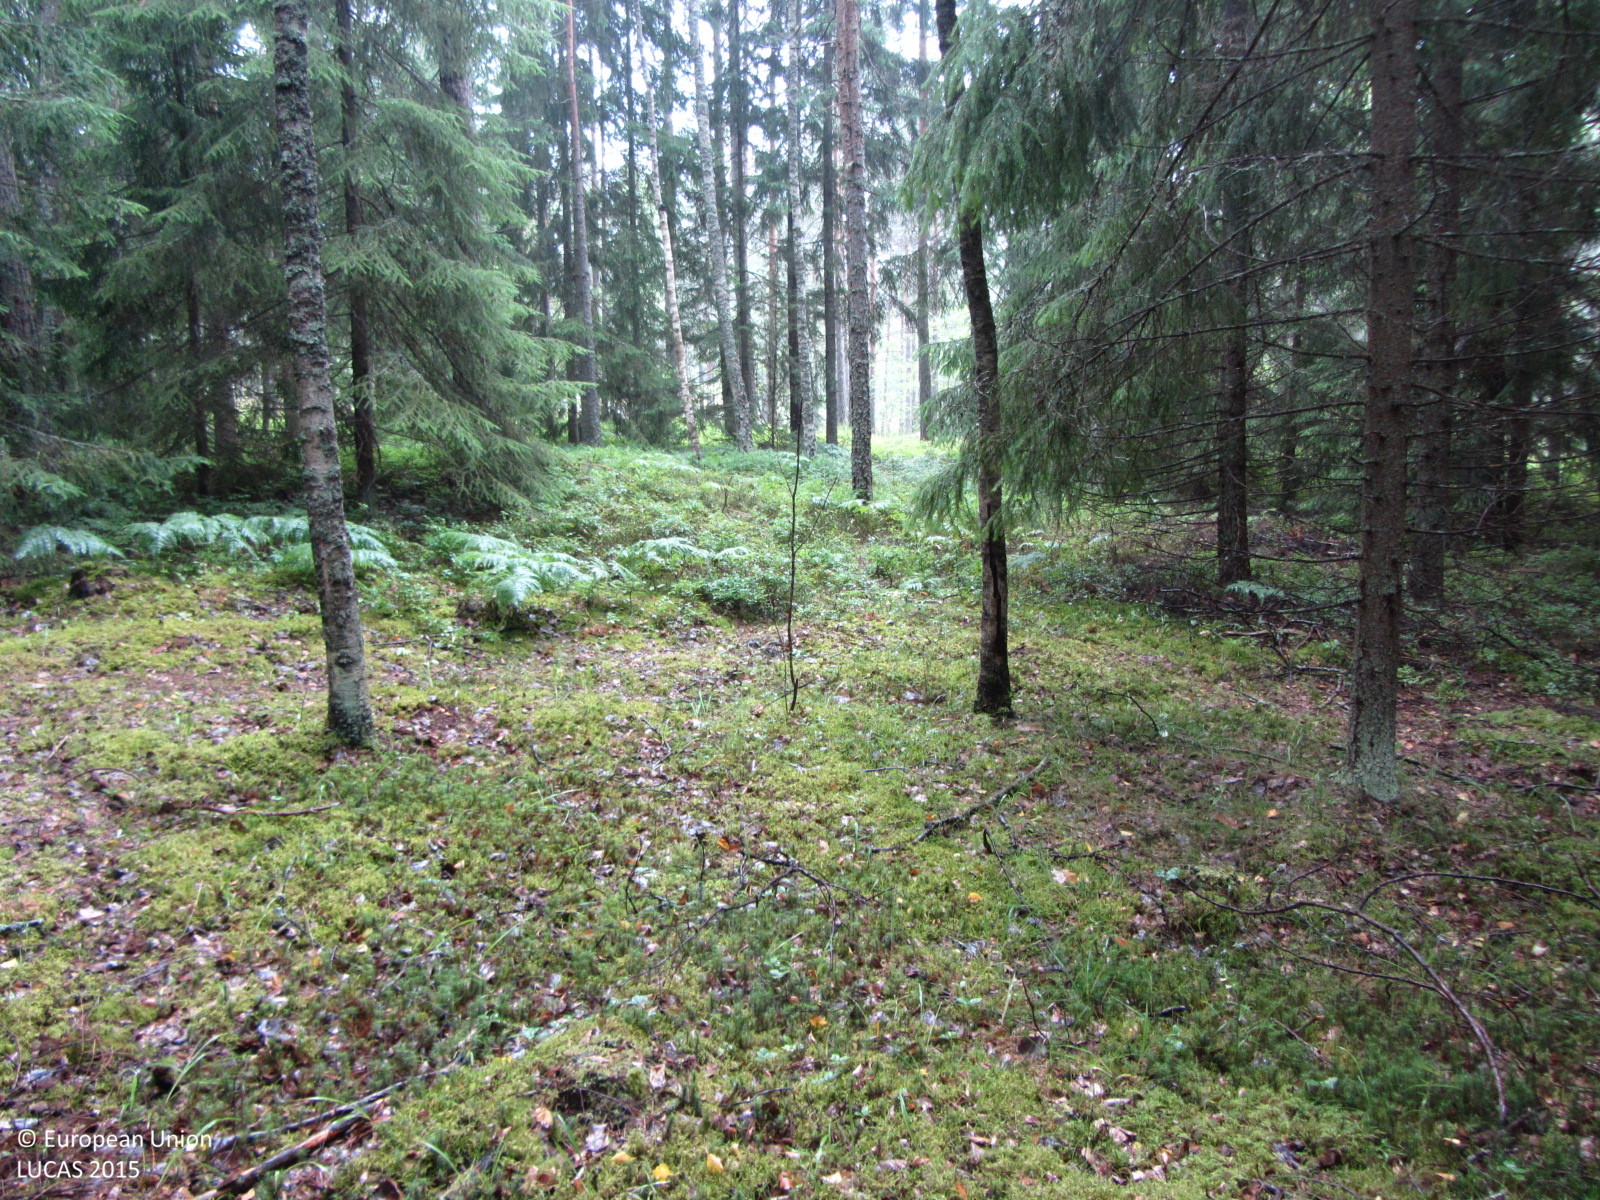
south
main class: Woodland
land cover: Spruce dominated mixed woodland
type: boreal forest
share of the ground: > 75 %
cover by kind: coniferous forest trees 60 %, broadleaved forest trees 25 %, lichens and mosses 10 %, herbaceous plants 5 %
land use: Forestry
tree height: > 5 m
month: July
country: FI
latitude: 59.9679
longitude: 23.1059
